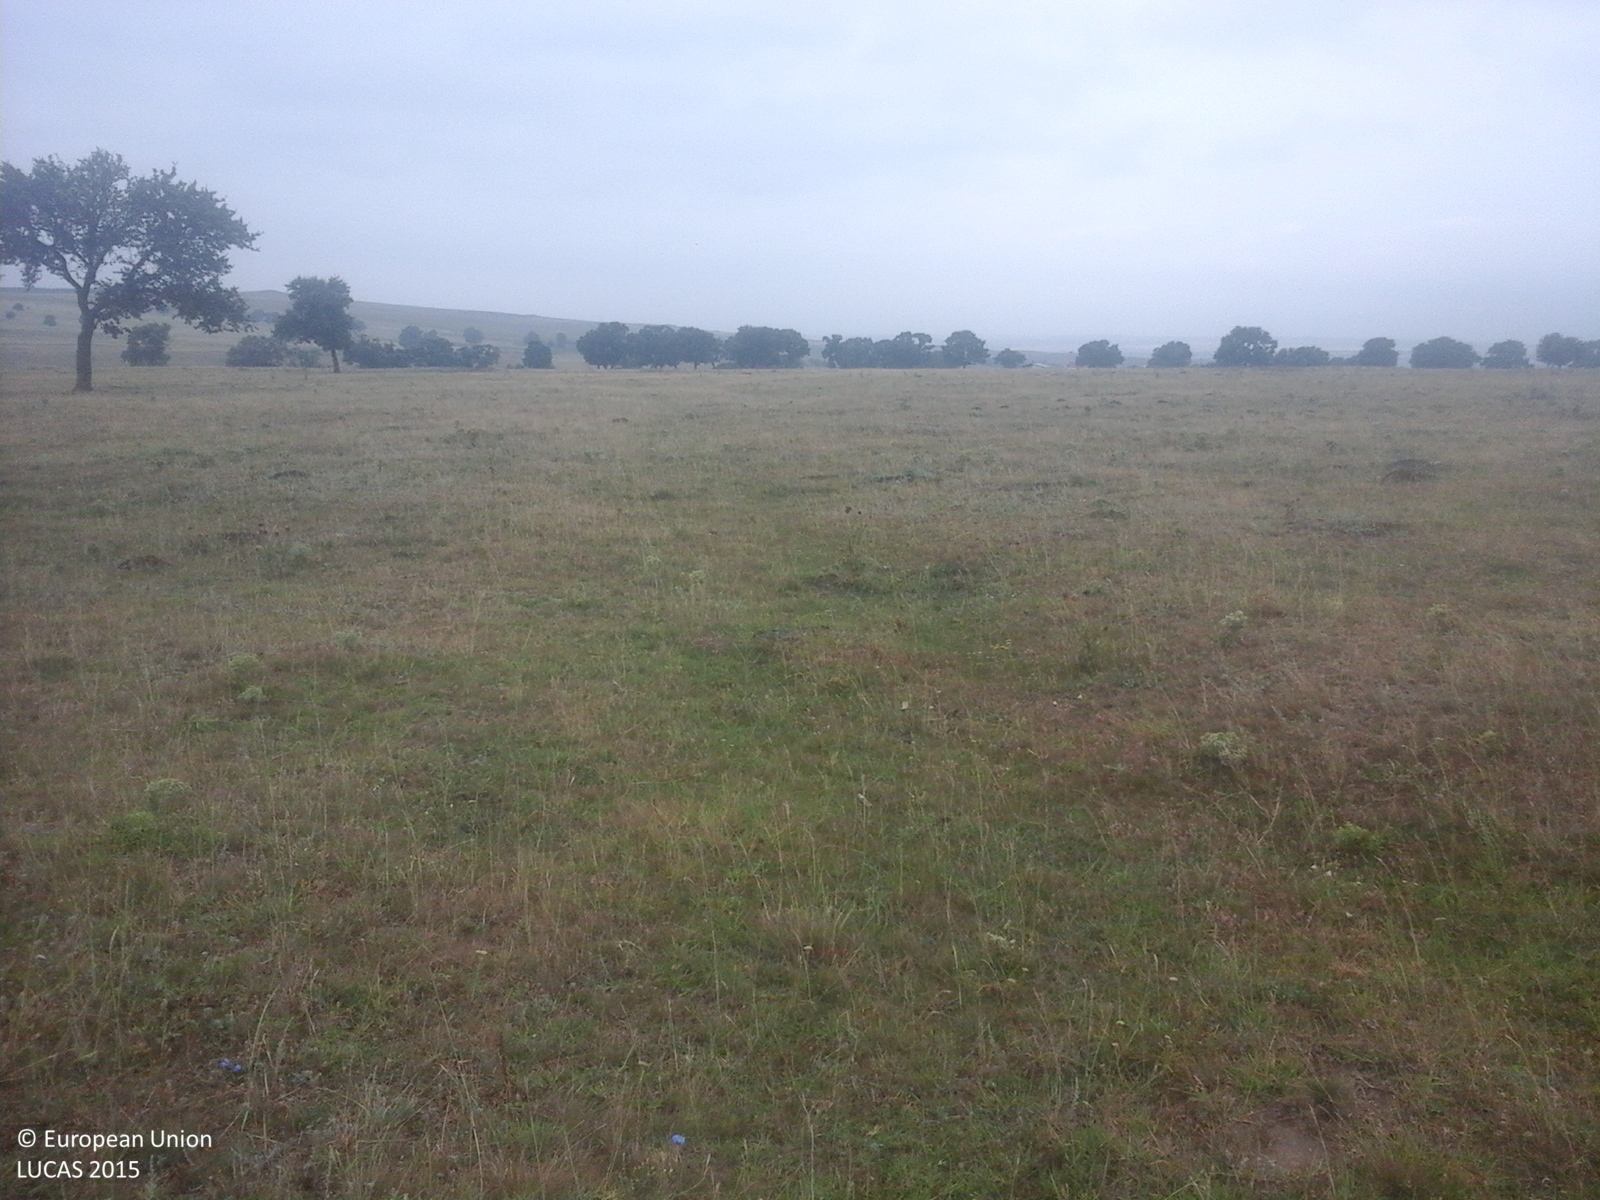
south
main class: Grassland
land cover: Grassland without tree/shrub cover
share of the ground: > 75 %
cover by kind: herbaceous plants 100 %
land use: Agriculture (excluding fallow land and kitchen gardens)
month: August
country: RO
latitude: 44.7680
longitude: 28.4323
